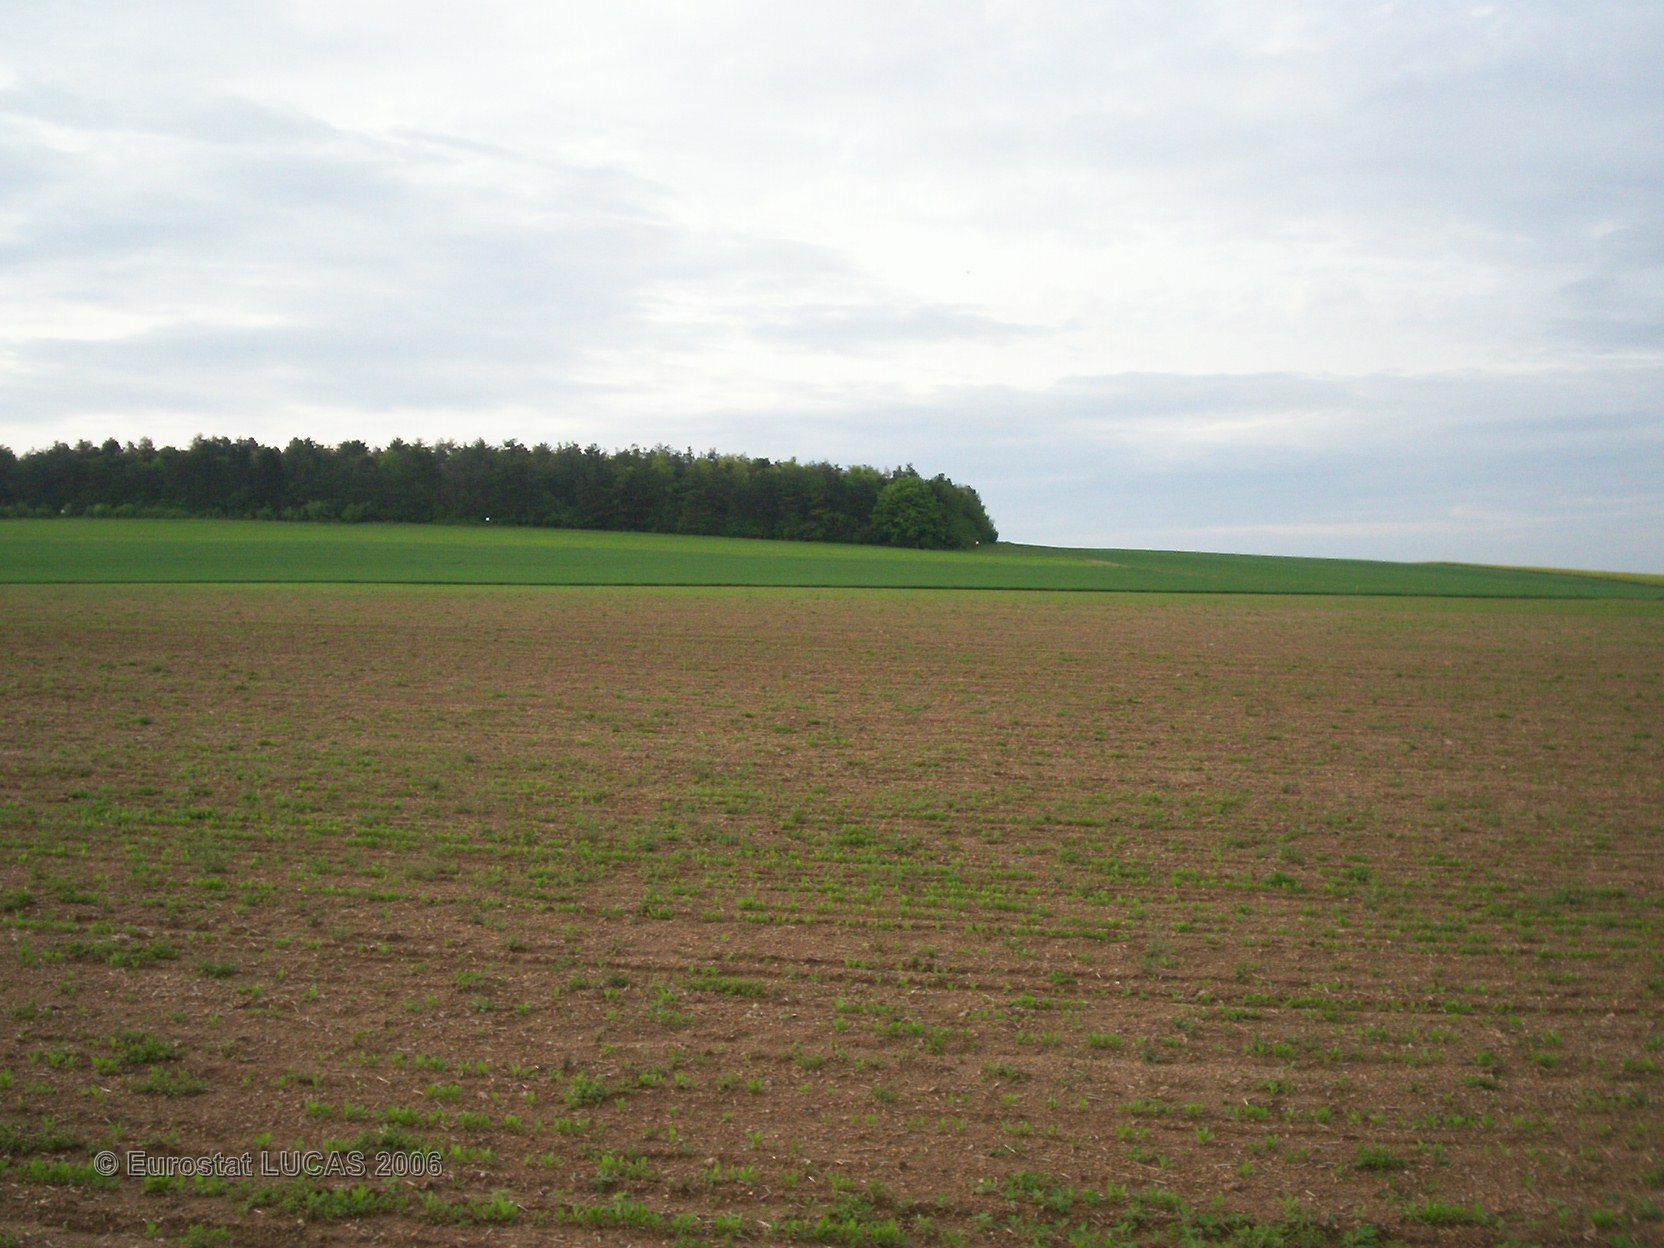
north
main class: Cropland
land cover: Other fibre and oleaginous crops
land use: Agriculture (excluding fallow land and kitchen gardens)
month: May
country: FR
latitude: 49.2150
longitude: 4.3538
